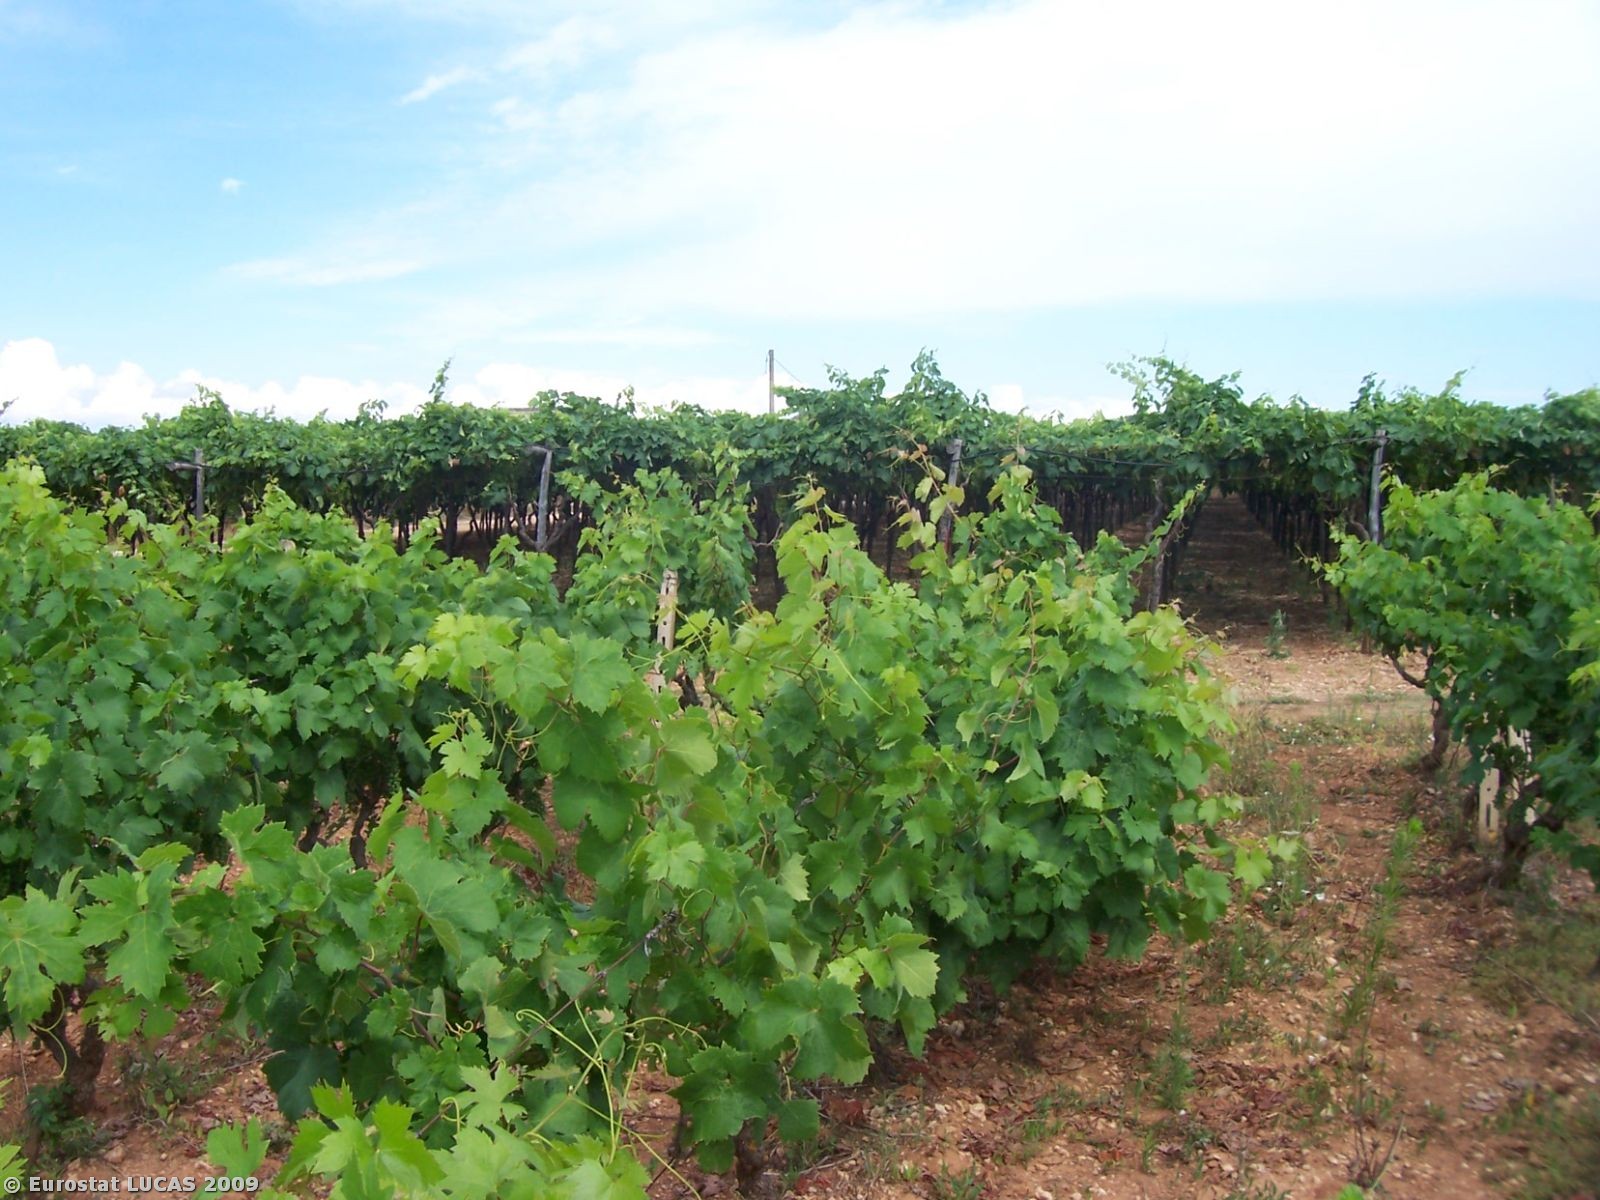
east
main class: Cropland
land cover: Vineyards
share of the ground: 25 - 50 %
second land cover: Bare land
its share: > 75 %
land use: Agriculture (excluding fallow land and kitchen gardens)
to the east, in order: Vineyards; Bare land; Vineyards; Bare land; Tracks; Vineyards; Bare land; Paved roads, cycling and walking lanes; Artificial constructions in urban areas; Vineyards; Bare land; Fences; Grass margins; Paved roads, cycling and walking lanes; Grass margins; Vineyards; Bare land
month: June
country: IT
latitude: 40.3417
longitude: 17.5207
